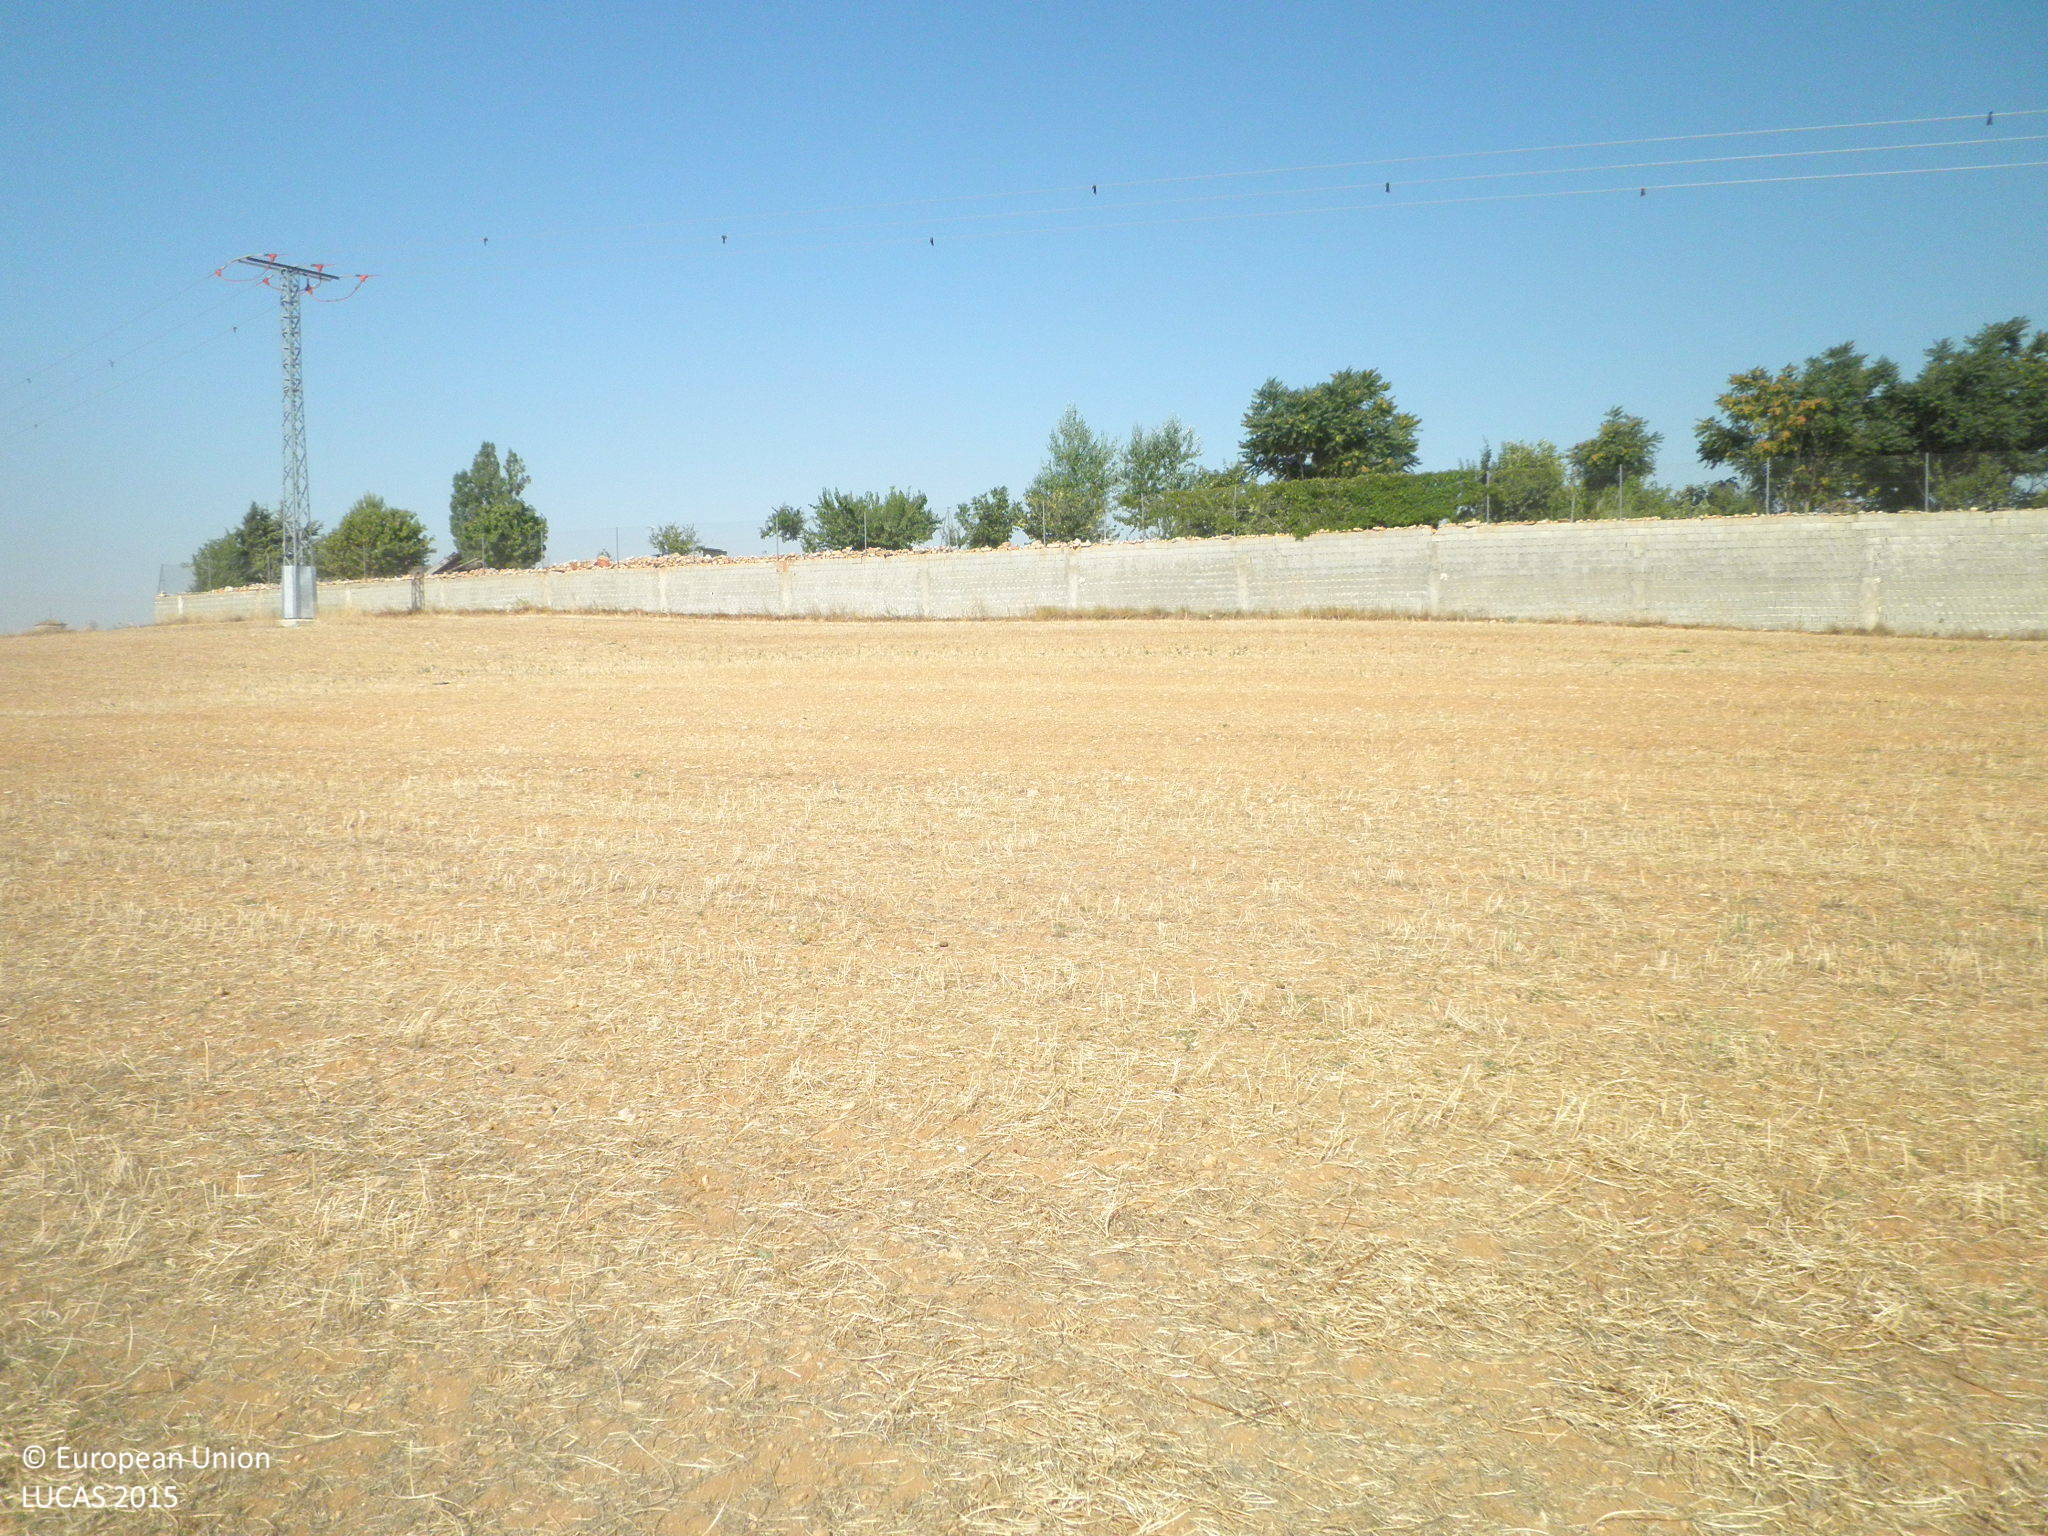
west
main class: Cropland
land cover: Dry pulses
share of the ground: < 10 %
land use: Agriculture (excluding fallow land and kitchen gardens)
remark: Harvested field
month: July
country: ES
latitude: 39.6095
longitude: -1.7827
